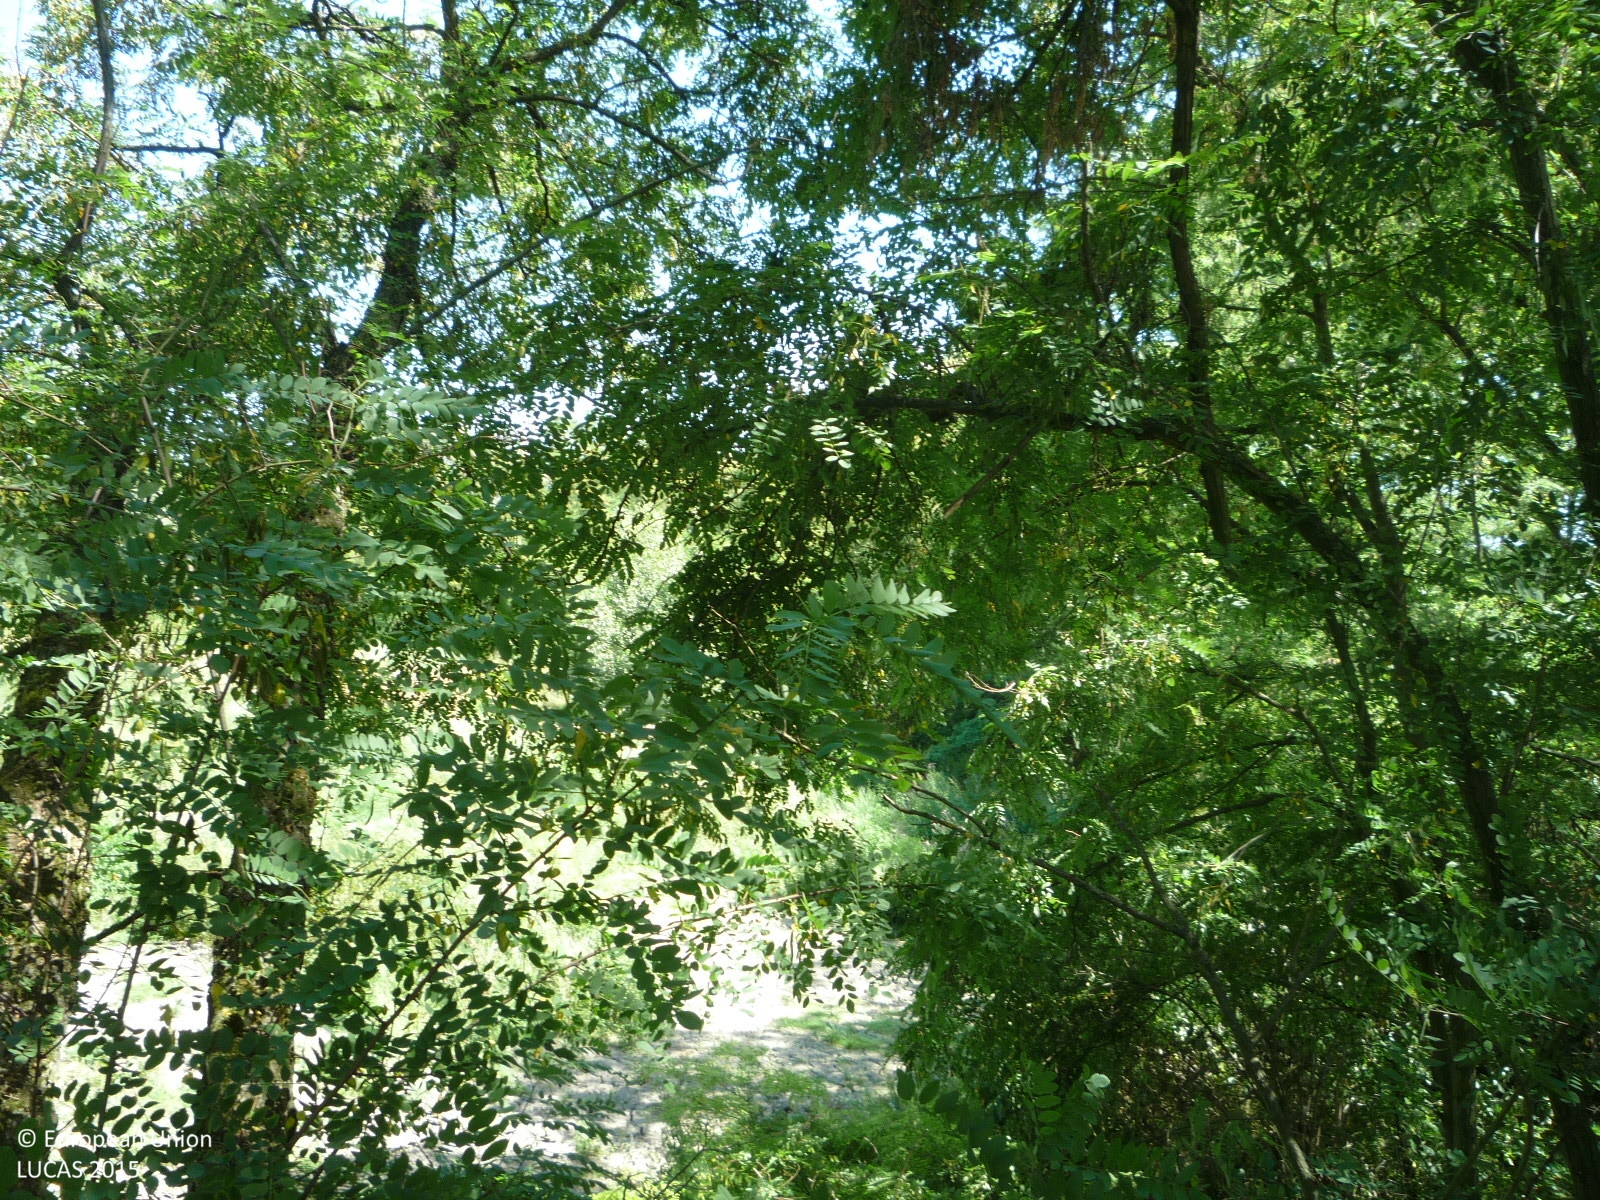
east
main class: Woodland
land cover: Broadleaved woodland
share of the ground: > 75 %
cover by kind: broadleaved forest trees 100 %
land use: Semi-natural and natural areas not in use
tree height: > 5 m
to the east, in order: Broadleaved woodland; Spontaneously vegetated surfaces; Other bare soil; Broadleaved woodland; Other mixed woodland; Artificial constructions in urban areas
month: July
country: CZ
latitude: 50.5091
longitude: 14.9522
